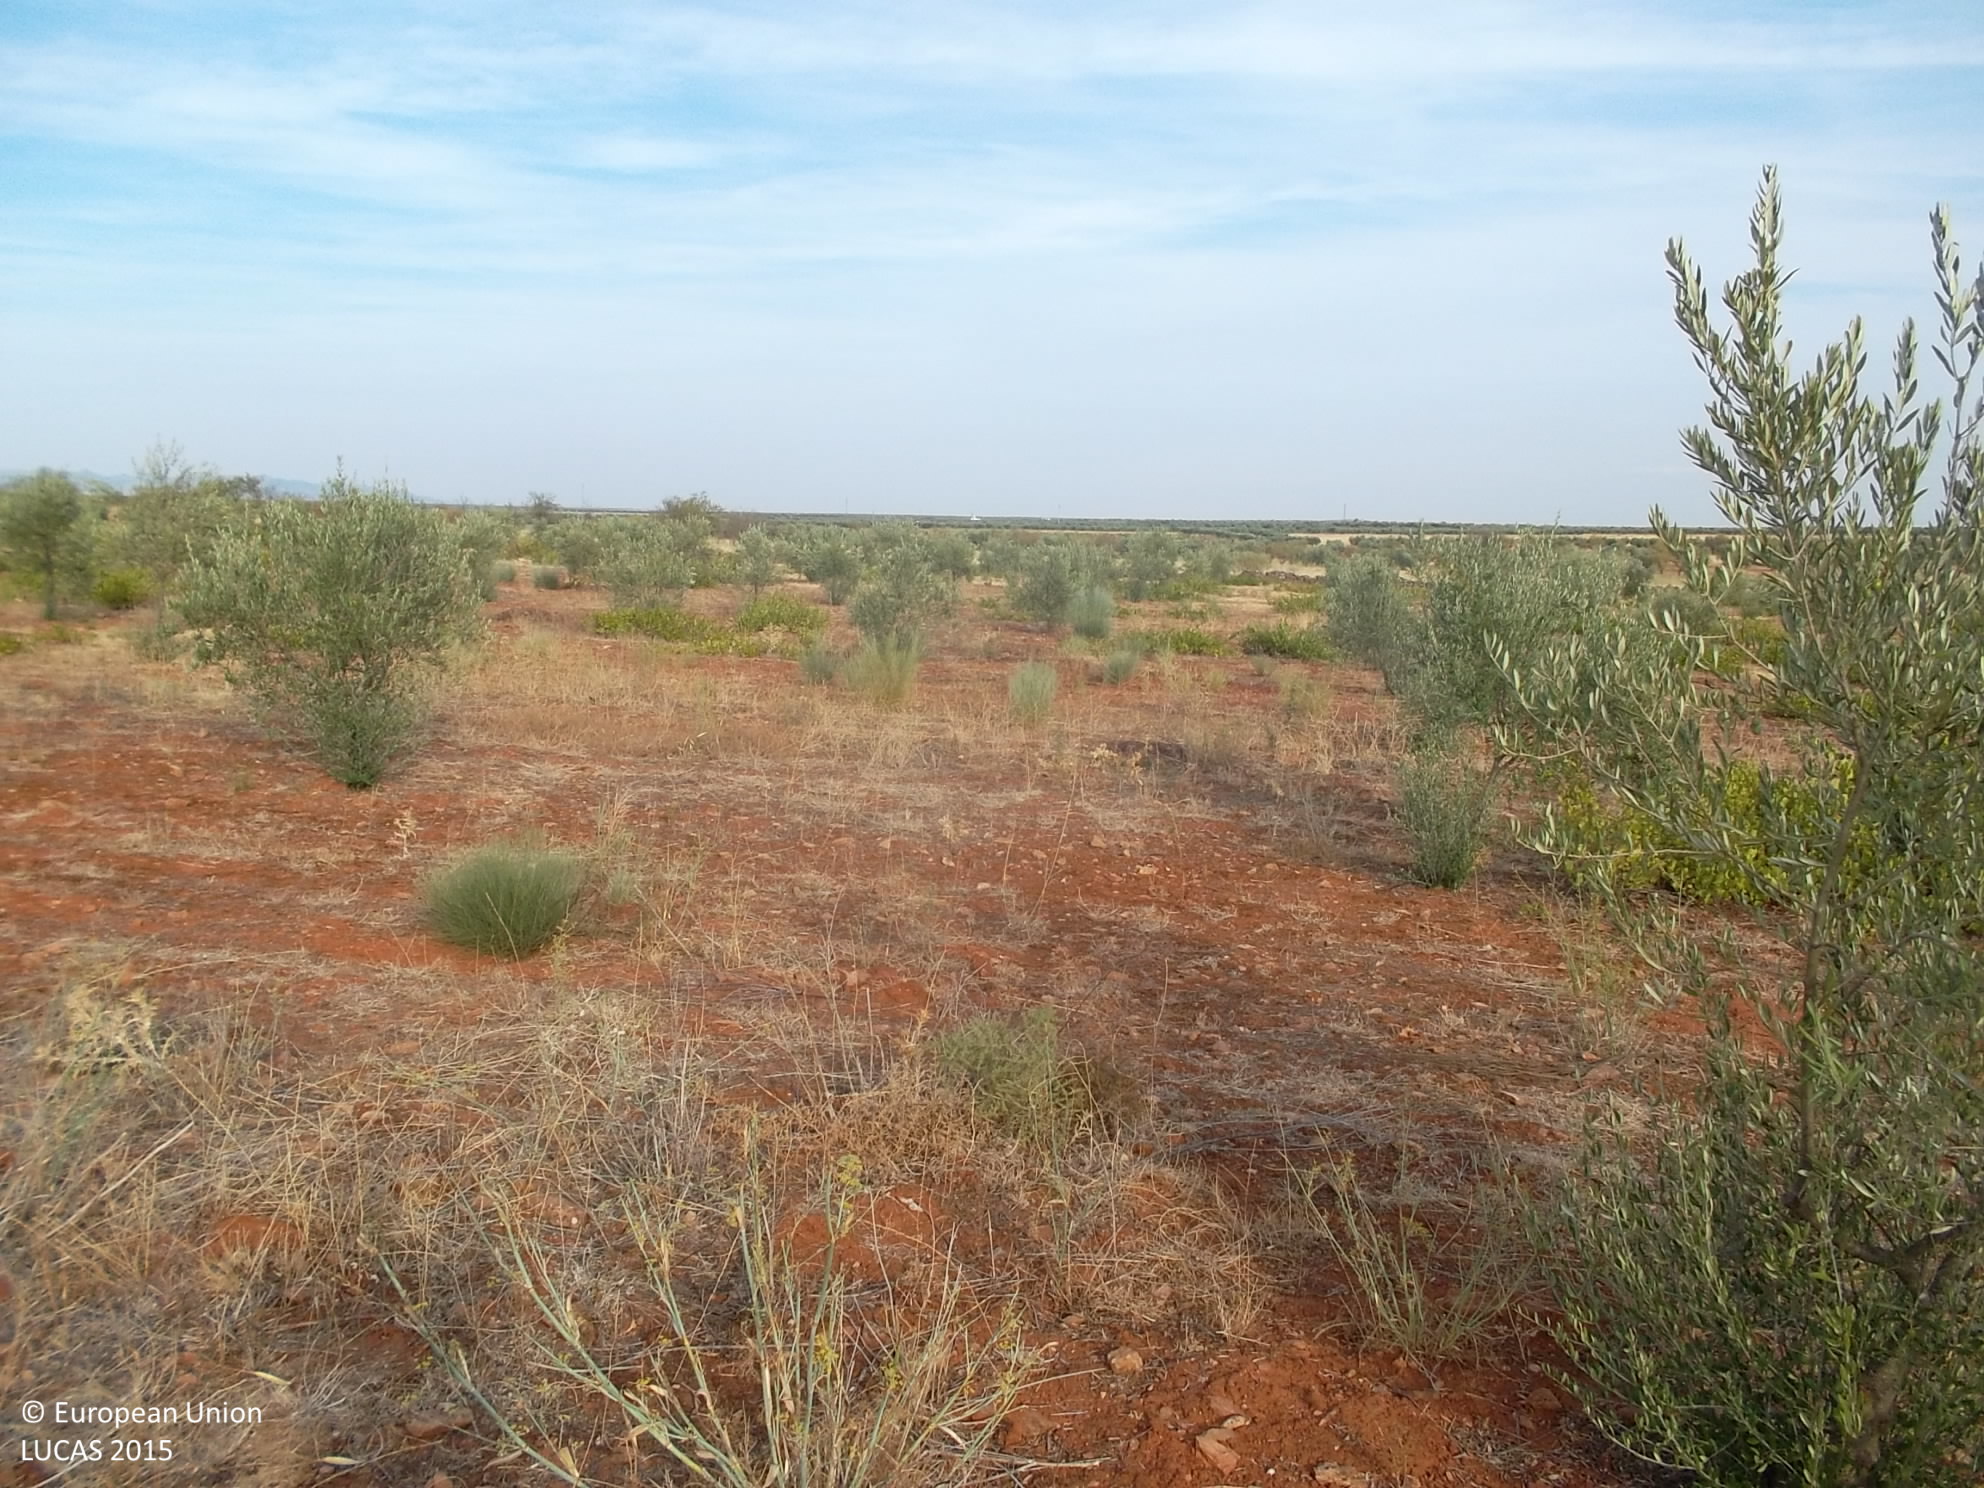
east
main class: Cropland
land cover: Olive groves
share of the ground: 10 - 25 %
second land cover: Grassland without tree/shrub cover
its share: > 75 %
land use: Agriculture (excluding fallow land and kitchen gardens)
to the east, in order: Olive groves; Grassland without tree/shrub cover; Dry stone walls; Olive groves; Spontaneously vegetated surfaces; Olive groves
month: September
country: ES
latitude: 38.4955
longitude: -6.3663
